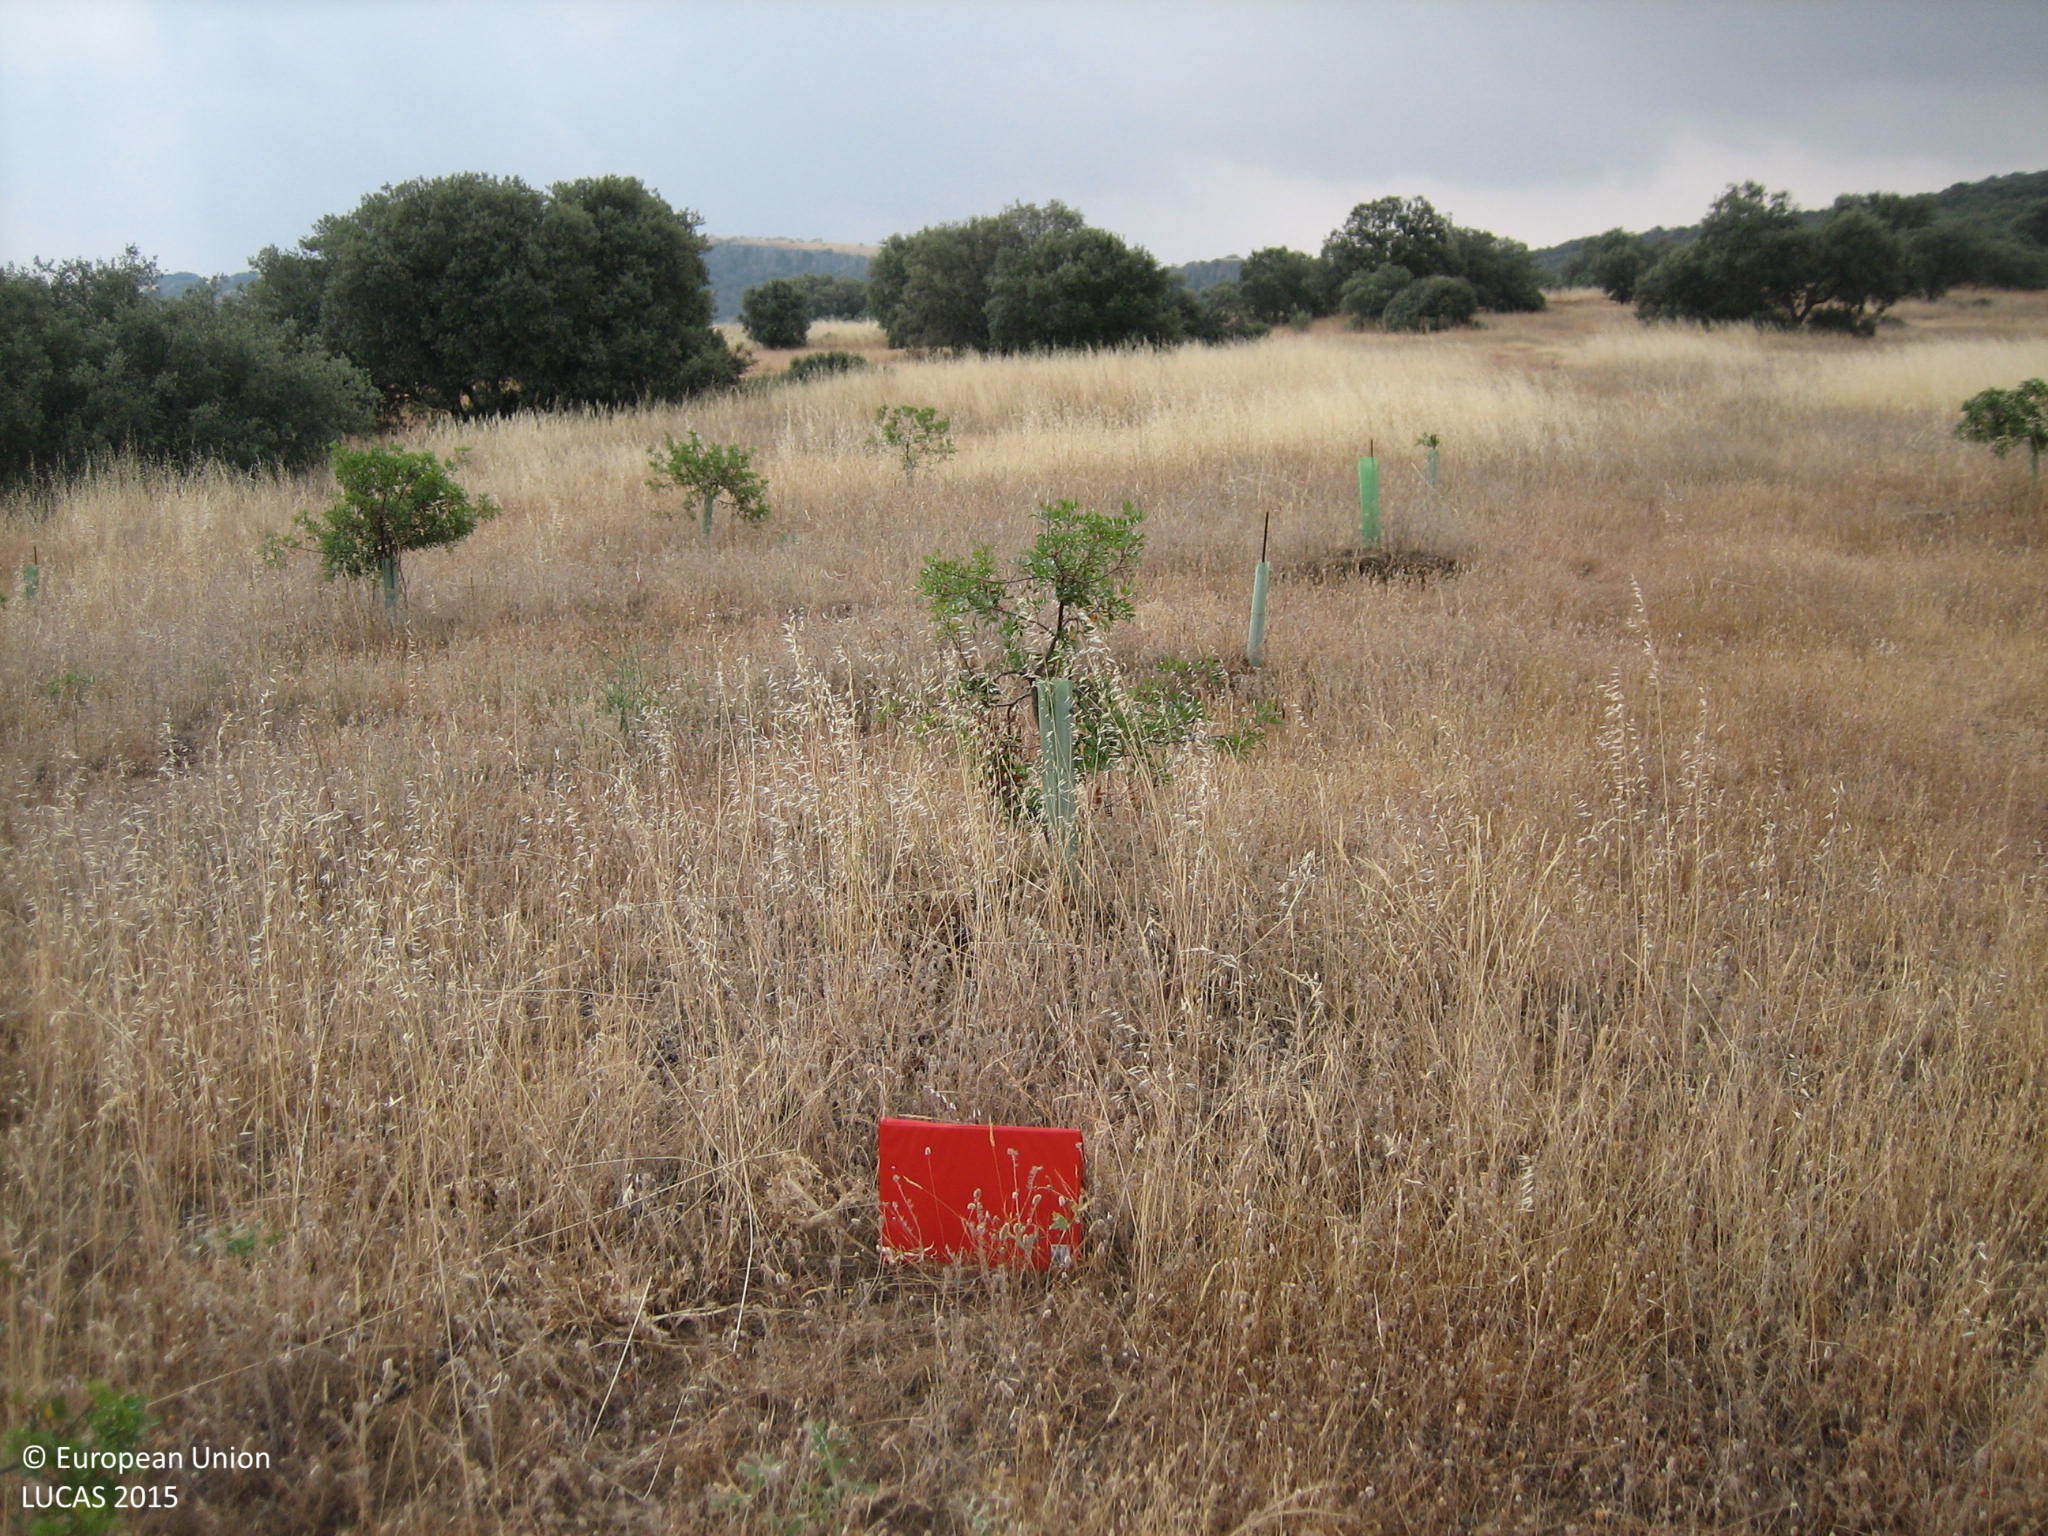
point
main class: Grassland
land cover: Grassland with sparse tree/shrub cover
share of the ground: > 75 %
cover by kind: herbaceous plants 90 %, broadleaved forest trees 5 %, shrubs 5 %
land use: Semi-natural and natural areas not in use
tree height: < 5 m
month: June
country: ES
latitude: 38.9372
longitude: -4.0614
